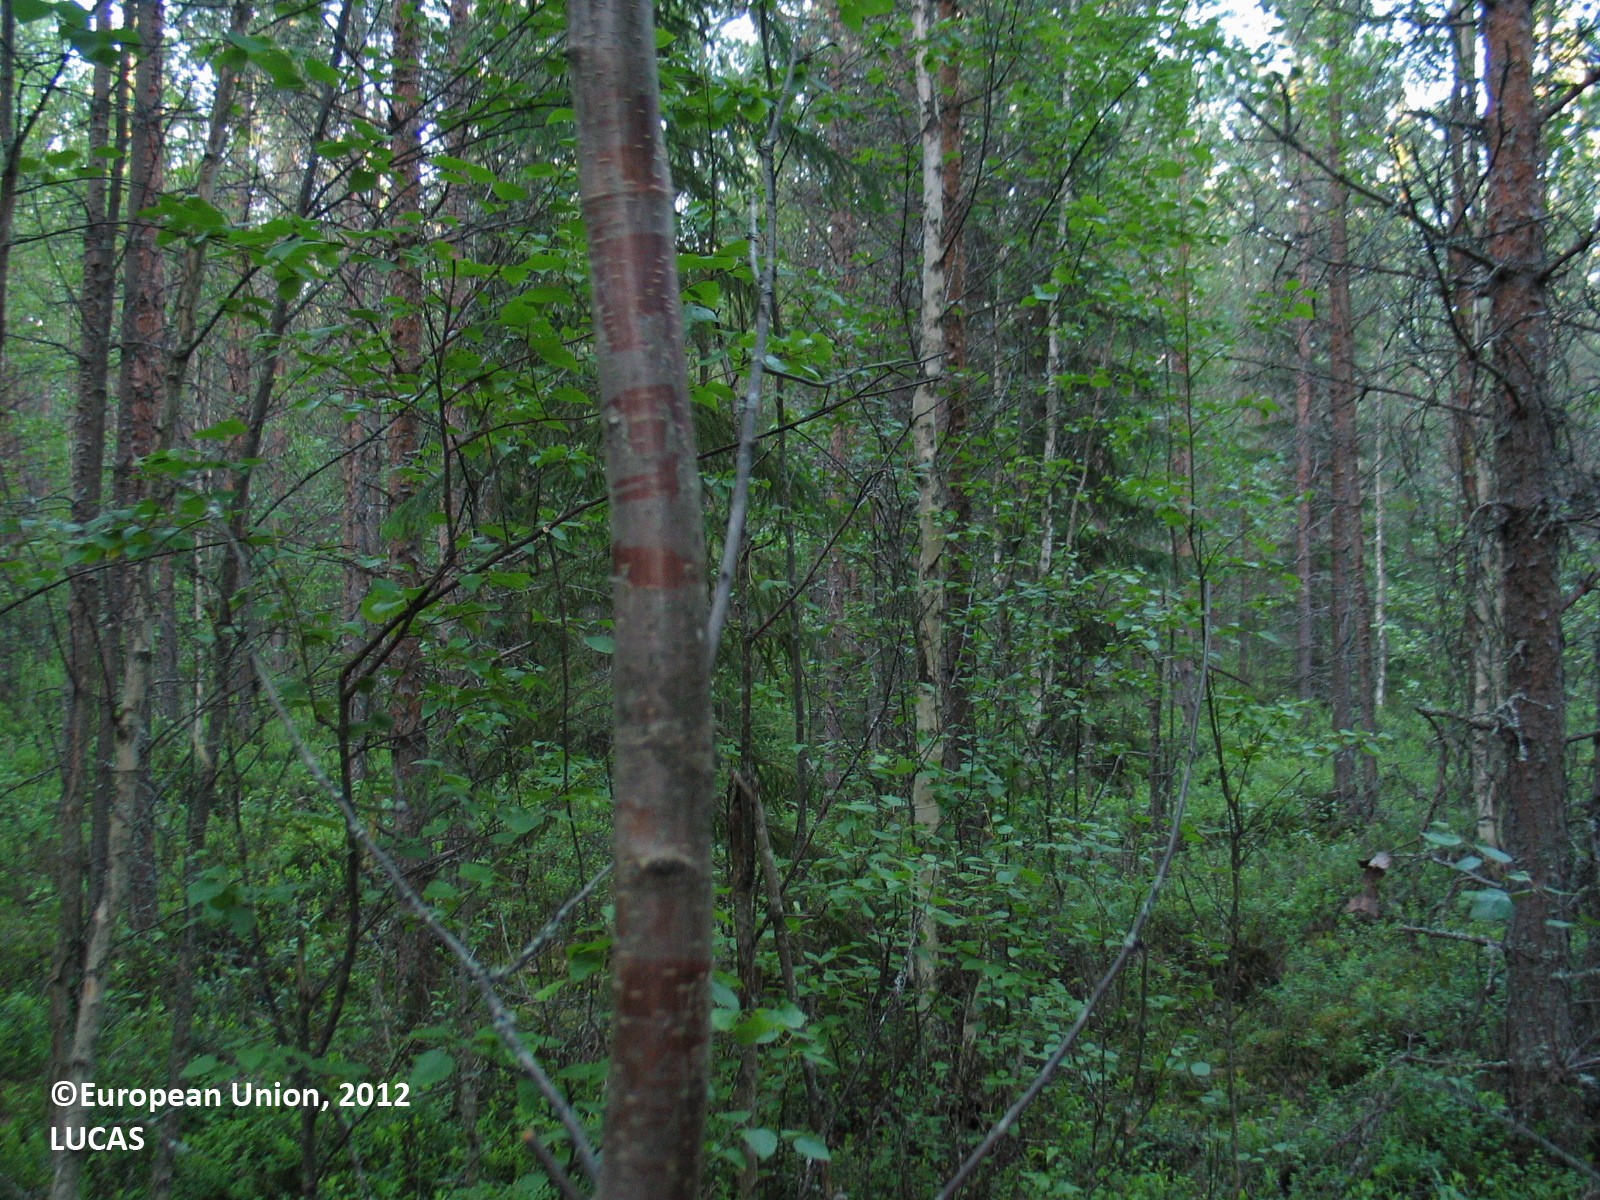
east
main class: Woodland
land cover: Pine dominated mixed woodland
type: boreal forest
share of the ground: > 75 %
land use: Forestry
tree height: > 5 m
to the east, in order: Pine dominated mixed woodland; Pine dominated coniferous woodland; Other mixed woodland; Ditches and canals; Broadleaved woodland; Other mixed woodland; Ditches and canals; Other mixed woodland; Ditches and canals; Other mixed woodland
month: July
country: FI
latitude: 64.7912
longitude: 26.6328
